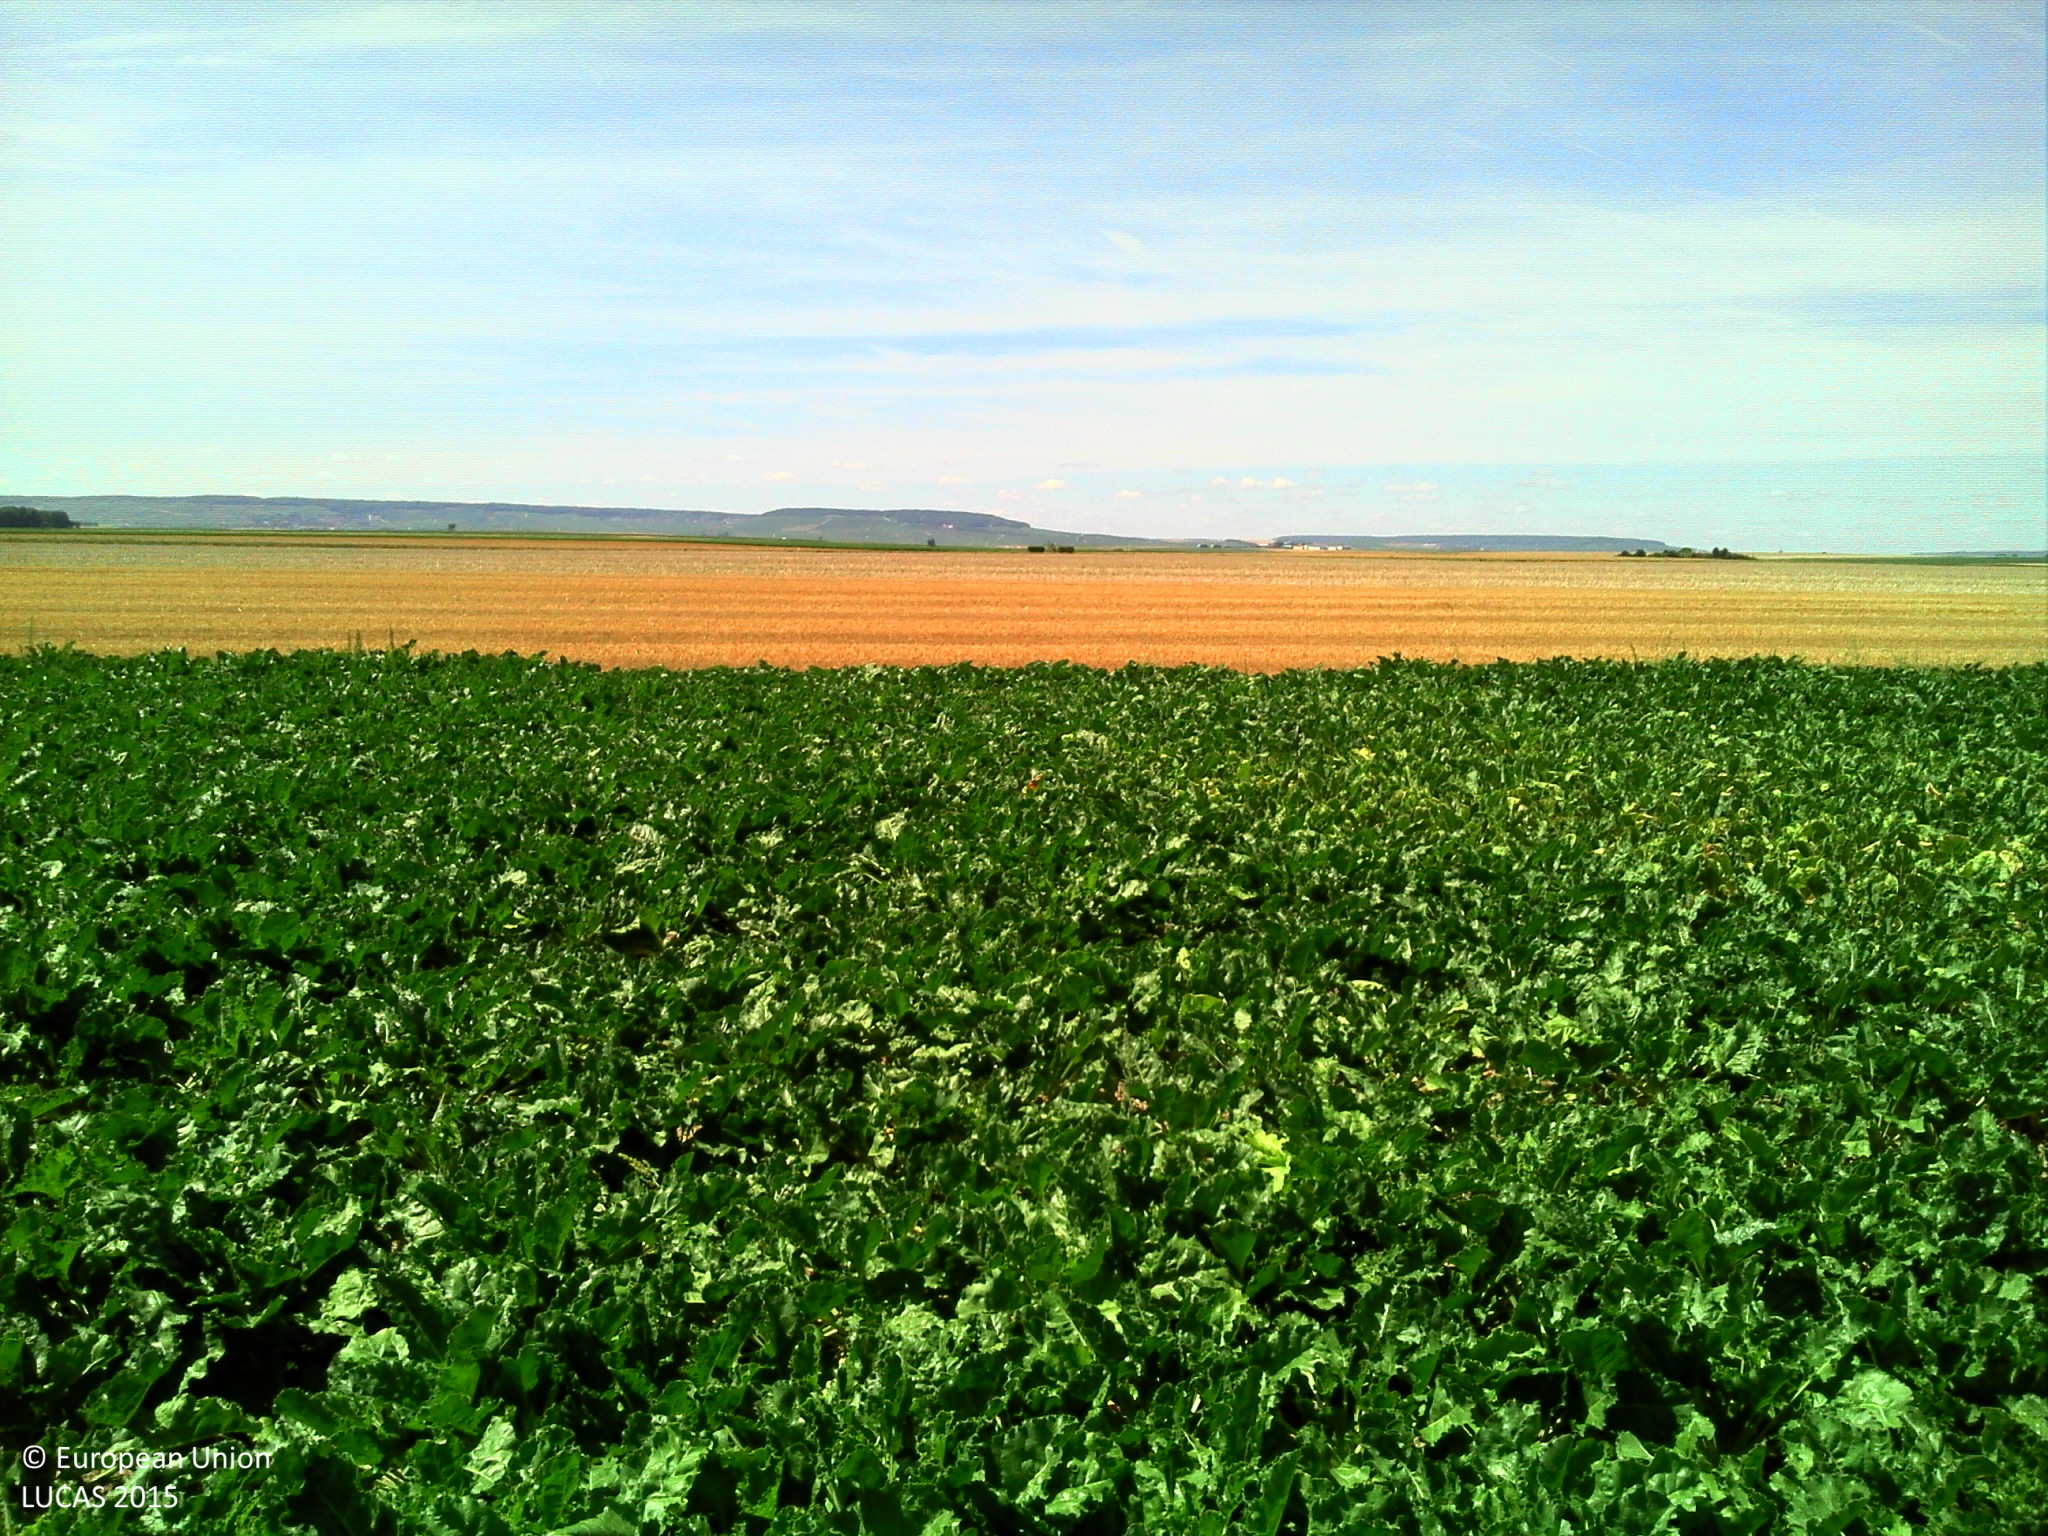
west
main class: Cropland
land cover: Sugar beet
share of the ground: > 75 %
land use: Agriculture (excluding fallow land and kitchen gardens)
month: August
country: FR
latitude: 49.0052
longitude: 4.1310
